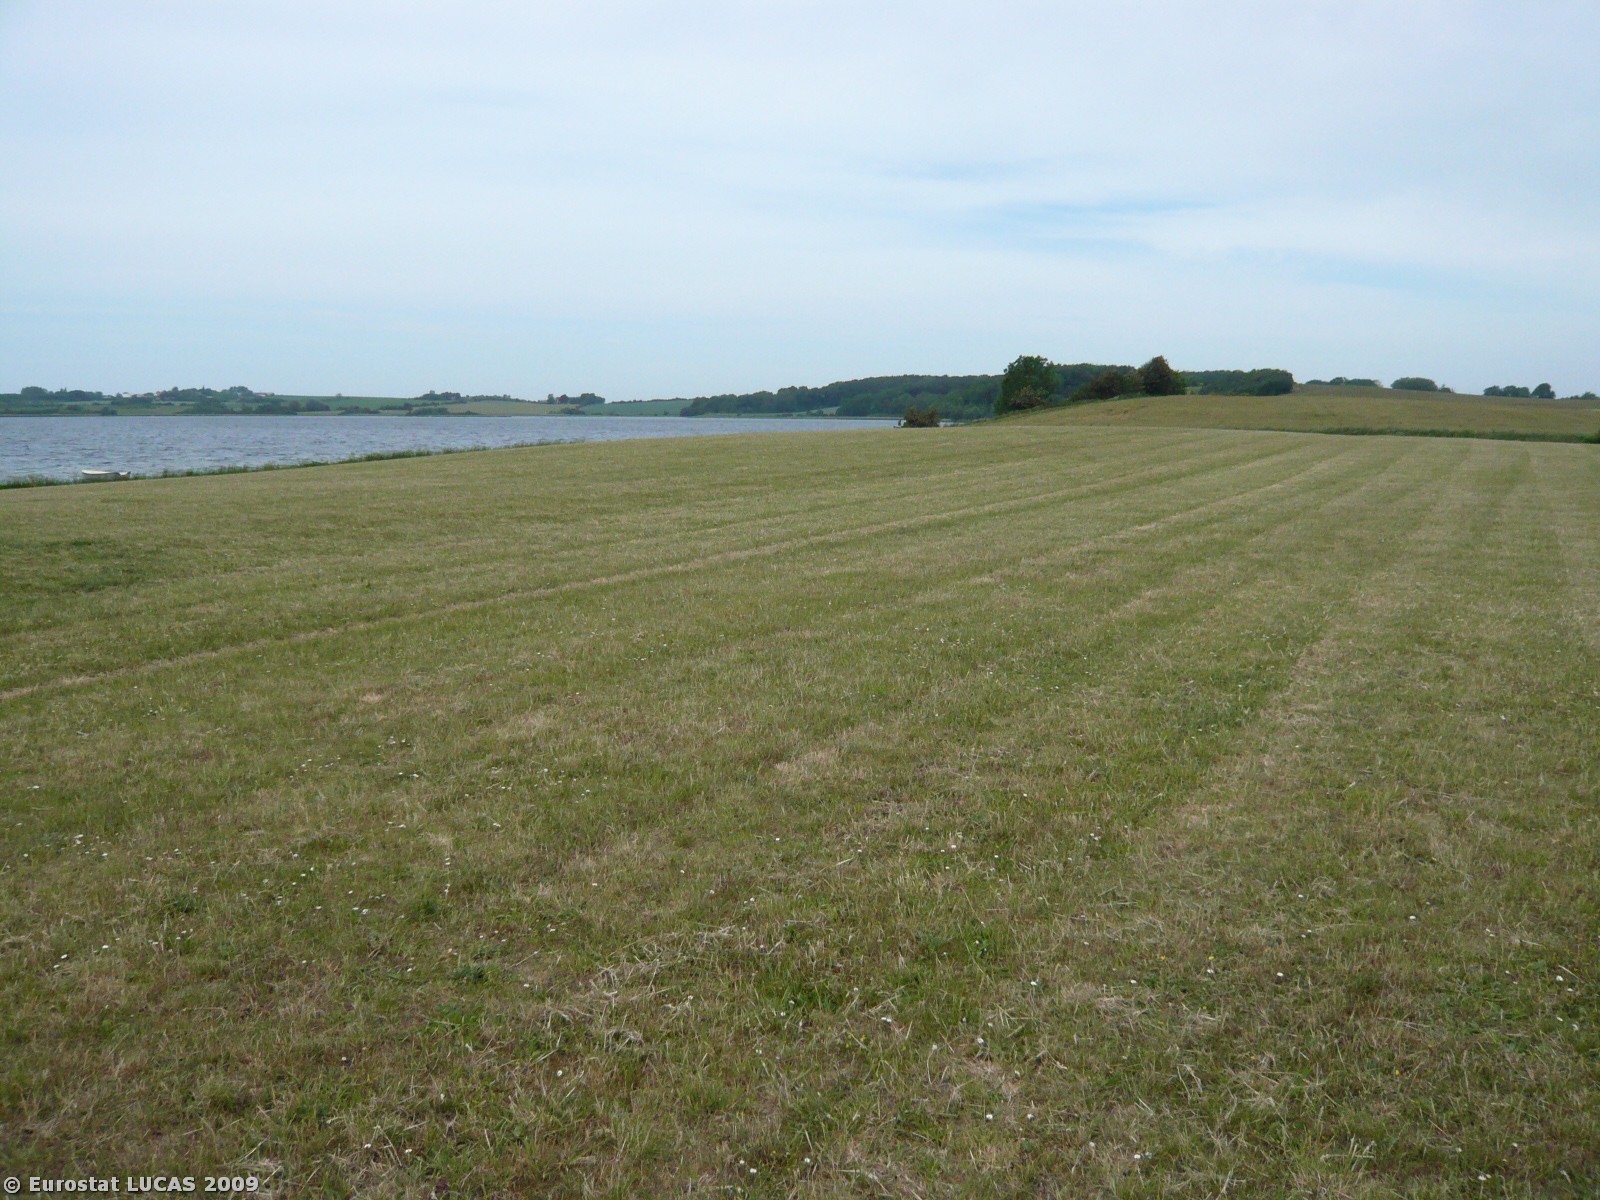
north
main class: Grassland
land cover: Grassland without tree/shrub cover
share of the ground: > 75 %
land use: Amenities, museums, leisure
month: June
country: DK
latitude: 55.2643
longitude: 11.3051
